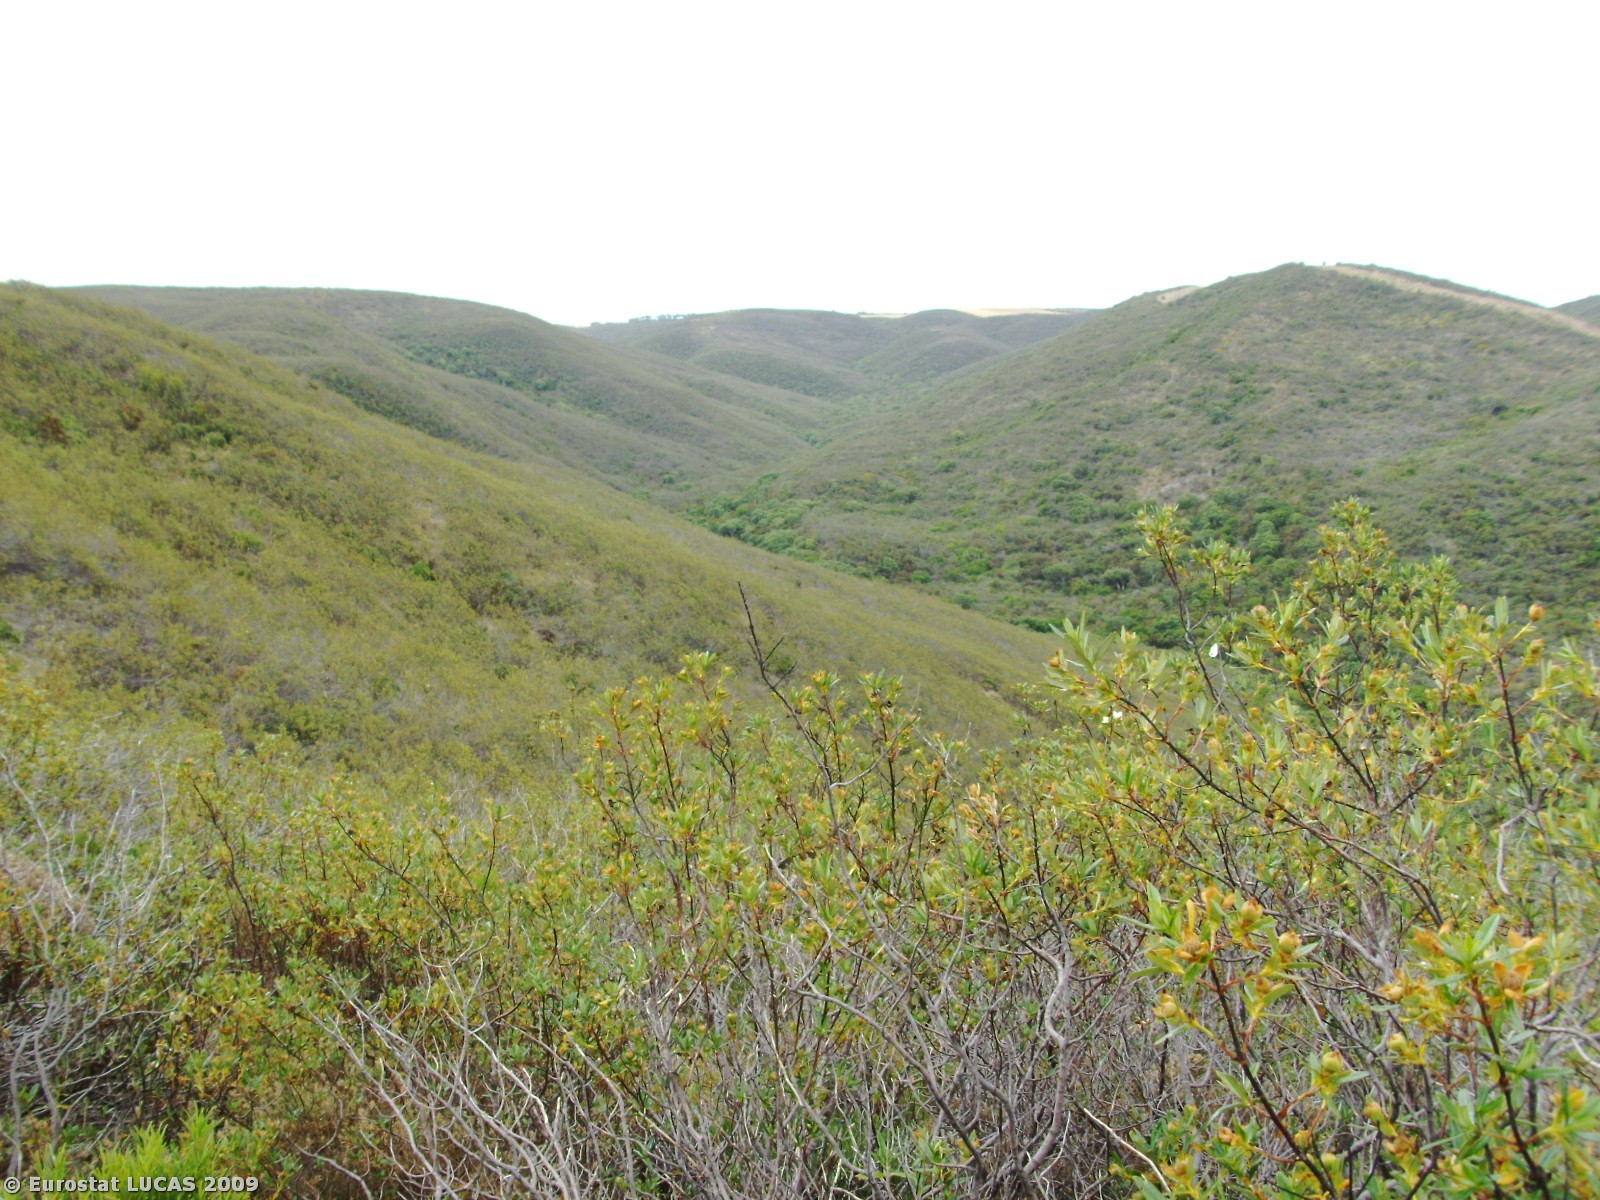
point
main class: Shrubland
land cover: Shrubland without tree cover
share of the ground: > 75 %
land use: Unused
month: June
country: PT
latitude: 37.1521
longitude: -8.8944
